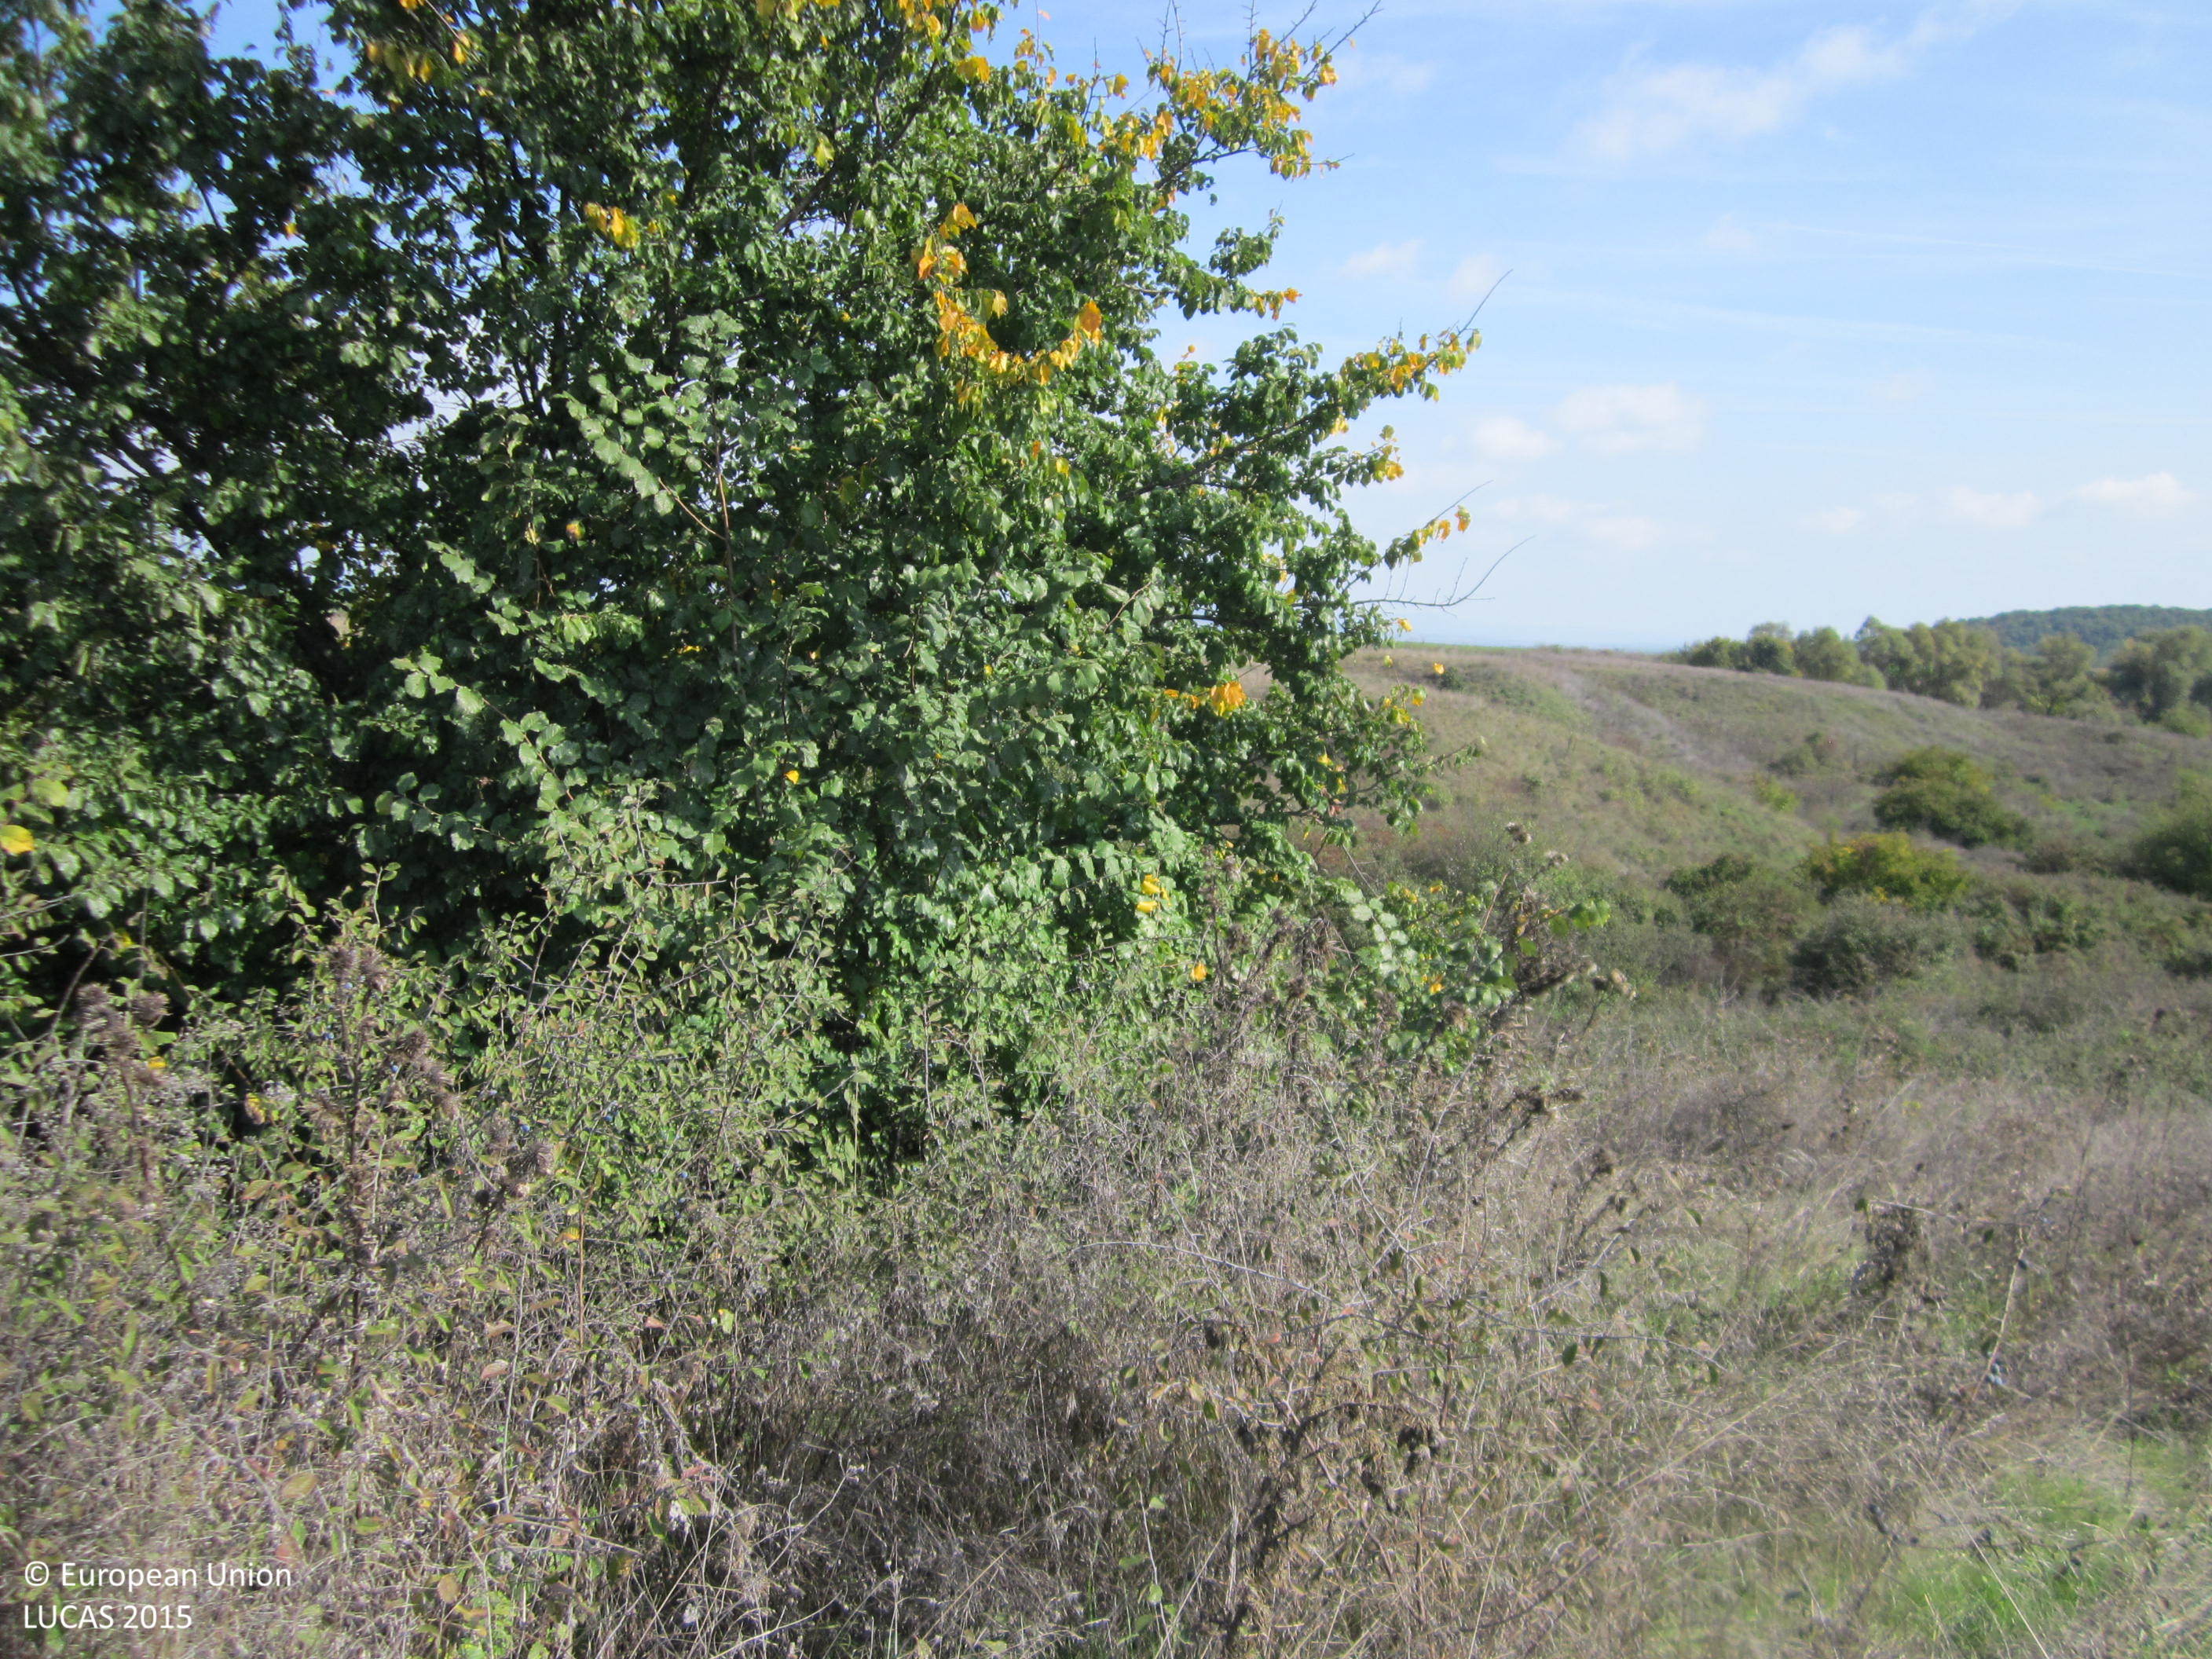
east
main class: Shrubland
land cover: Shrubland with sparse tree cover
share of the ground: 25 - 50 %
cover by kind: herbaceous plants 55 %, shrubs 40 %, broadleaved forest trees 5 %
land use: Semi-natural and natural areas not in use
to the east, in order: Shrubland with sparse tree cover; Ditches and canals; Shrubland with sparse tree cover; Grassland with sparse tree/shrub cover; Tracks; Grassland with sparse tree/shrub cover; Ditches and canals; Broadleaved woodland
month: October
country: BG
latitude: 42.7044
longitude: 26.8410
